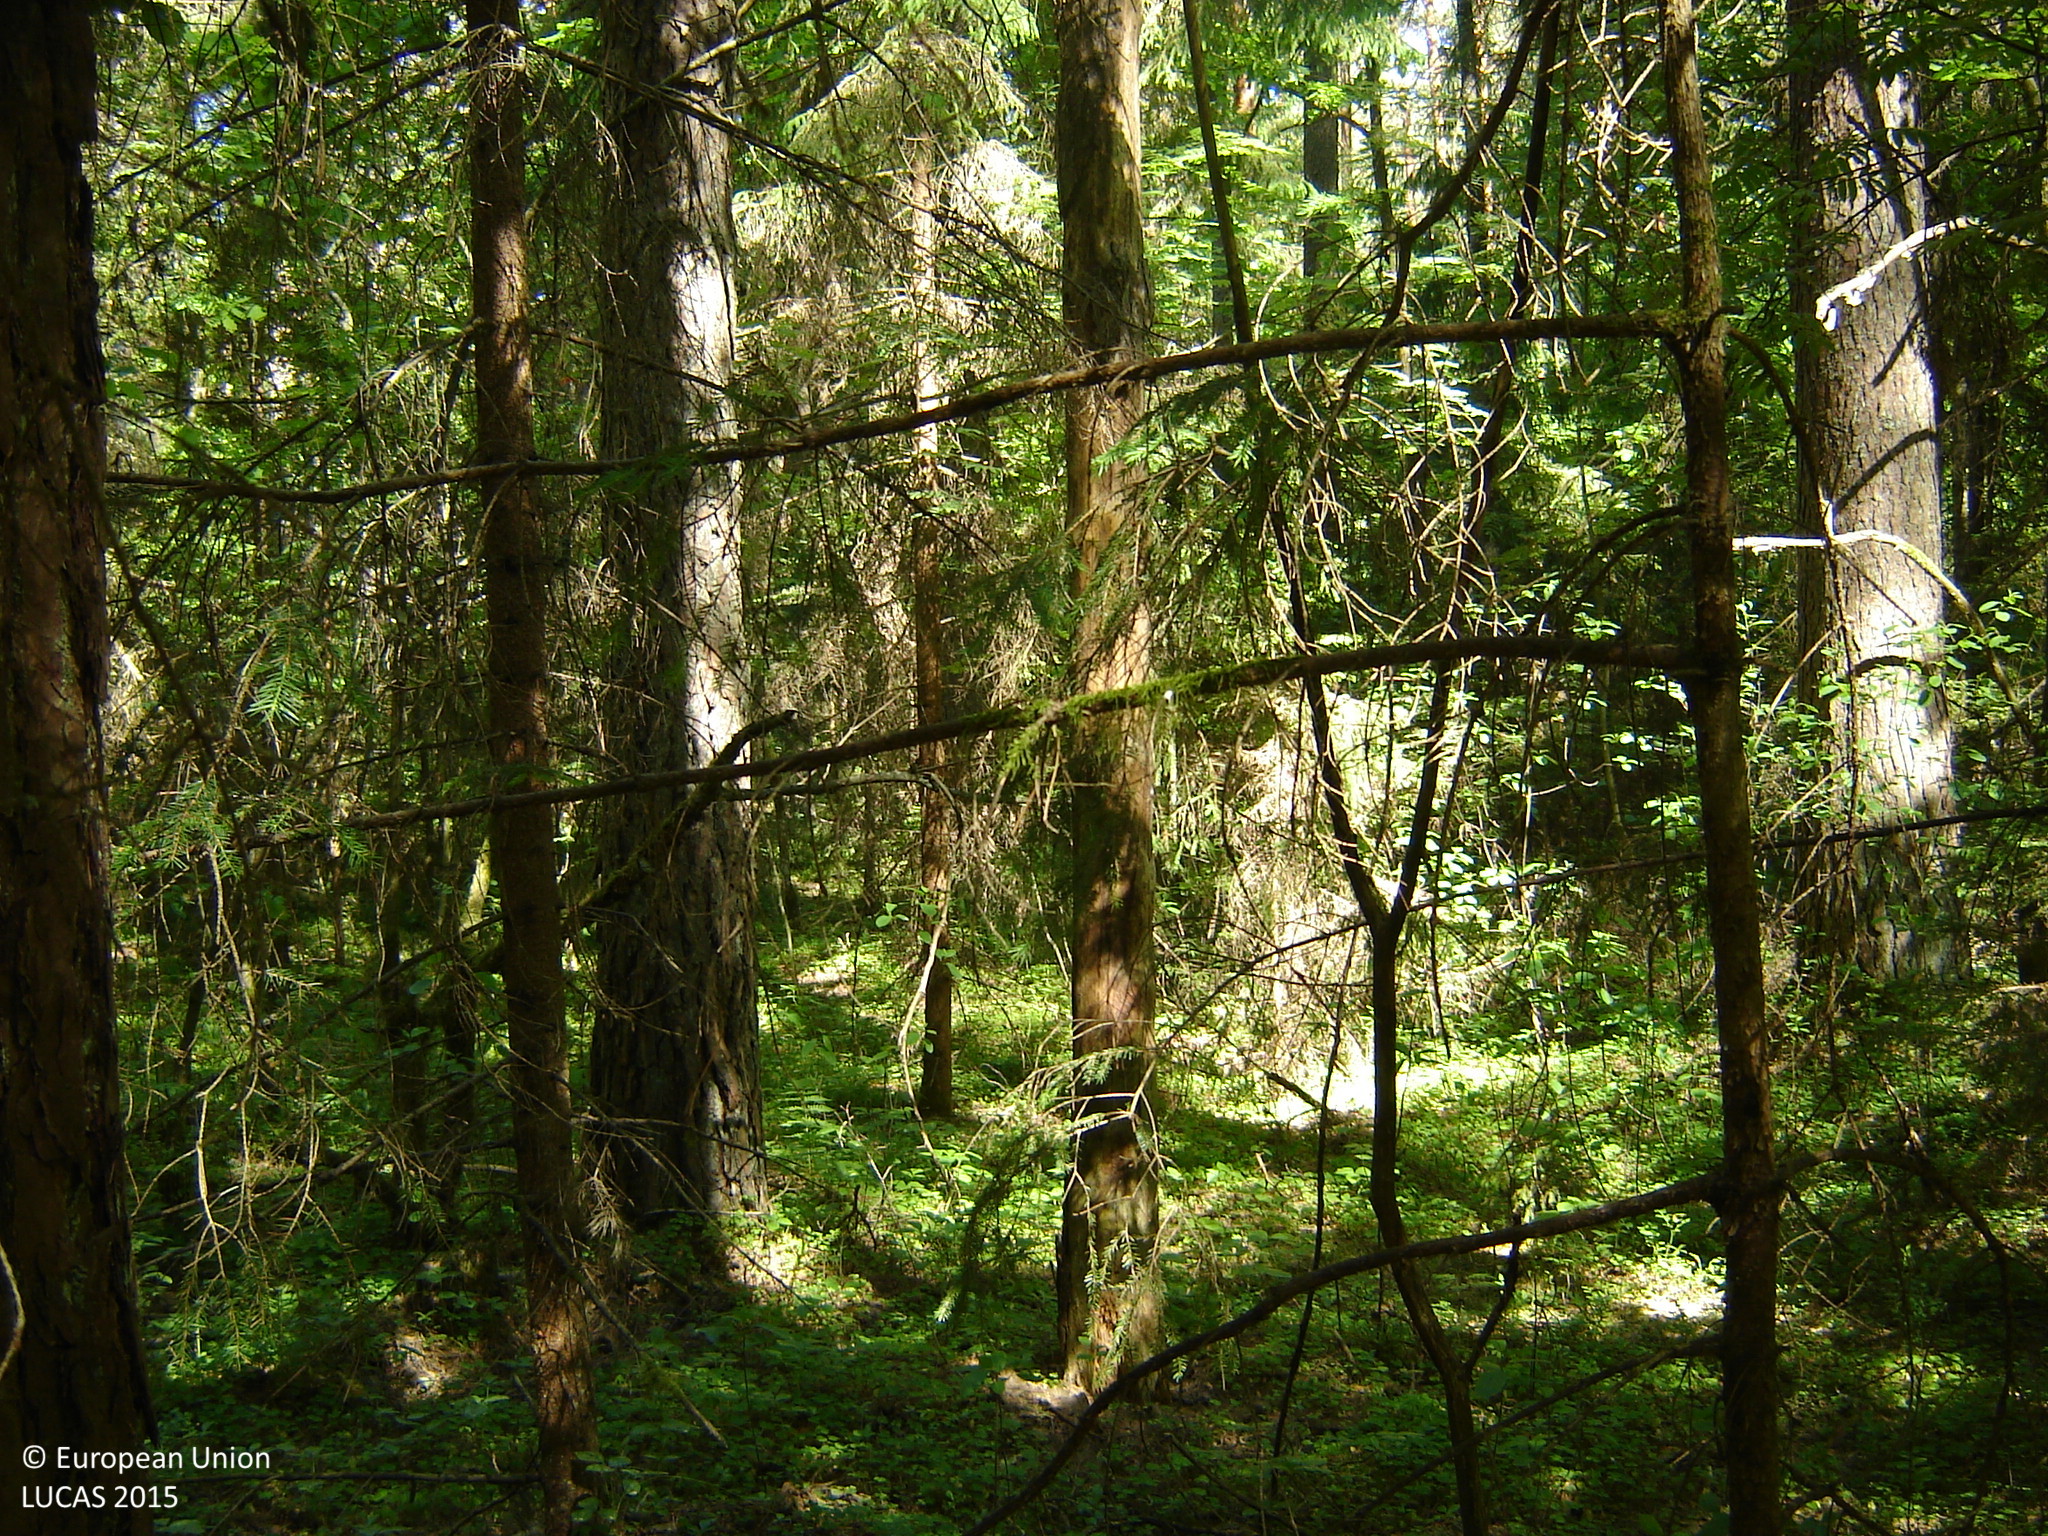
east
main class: Woodland
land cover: Other mixed woodland
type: hemiboreal forest and nemoral coniferous forest and mixed broadleaved-coniferous forest
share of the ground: > 75 %
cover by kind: coniferous forest trees 65 %, broadleaved forest trees 30 %, herbaceous plants 5 %
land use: Forestry
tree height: > 5 m
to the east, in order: Other mixed woodland; Pine dominated coniferous woodland; Tracks; Pine dominated coniferous woodland; Spruce dominated coniferous woodland
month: June
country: LT
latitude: 55.5581
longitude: 25.1286
